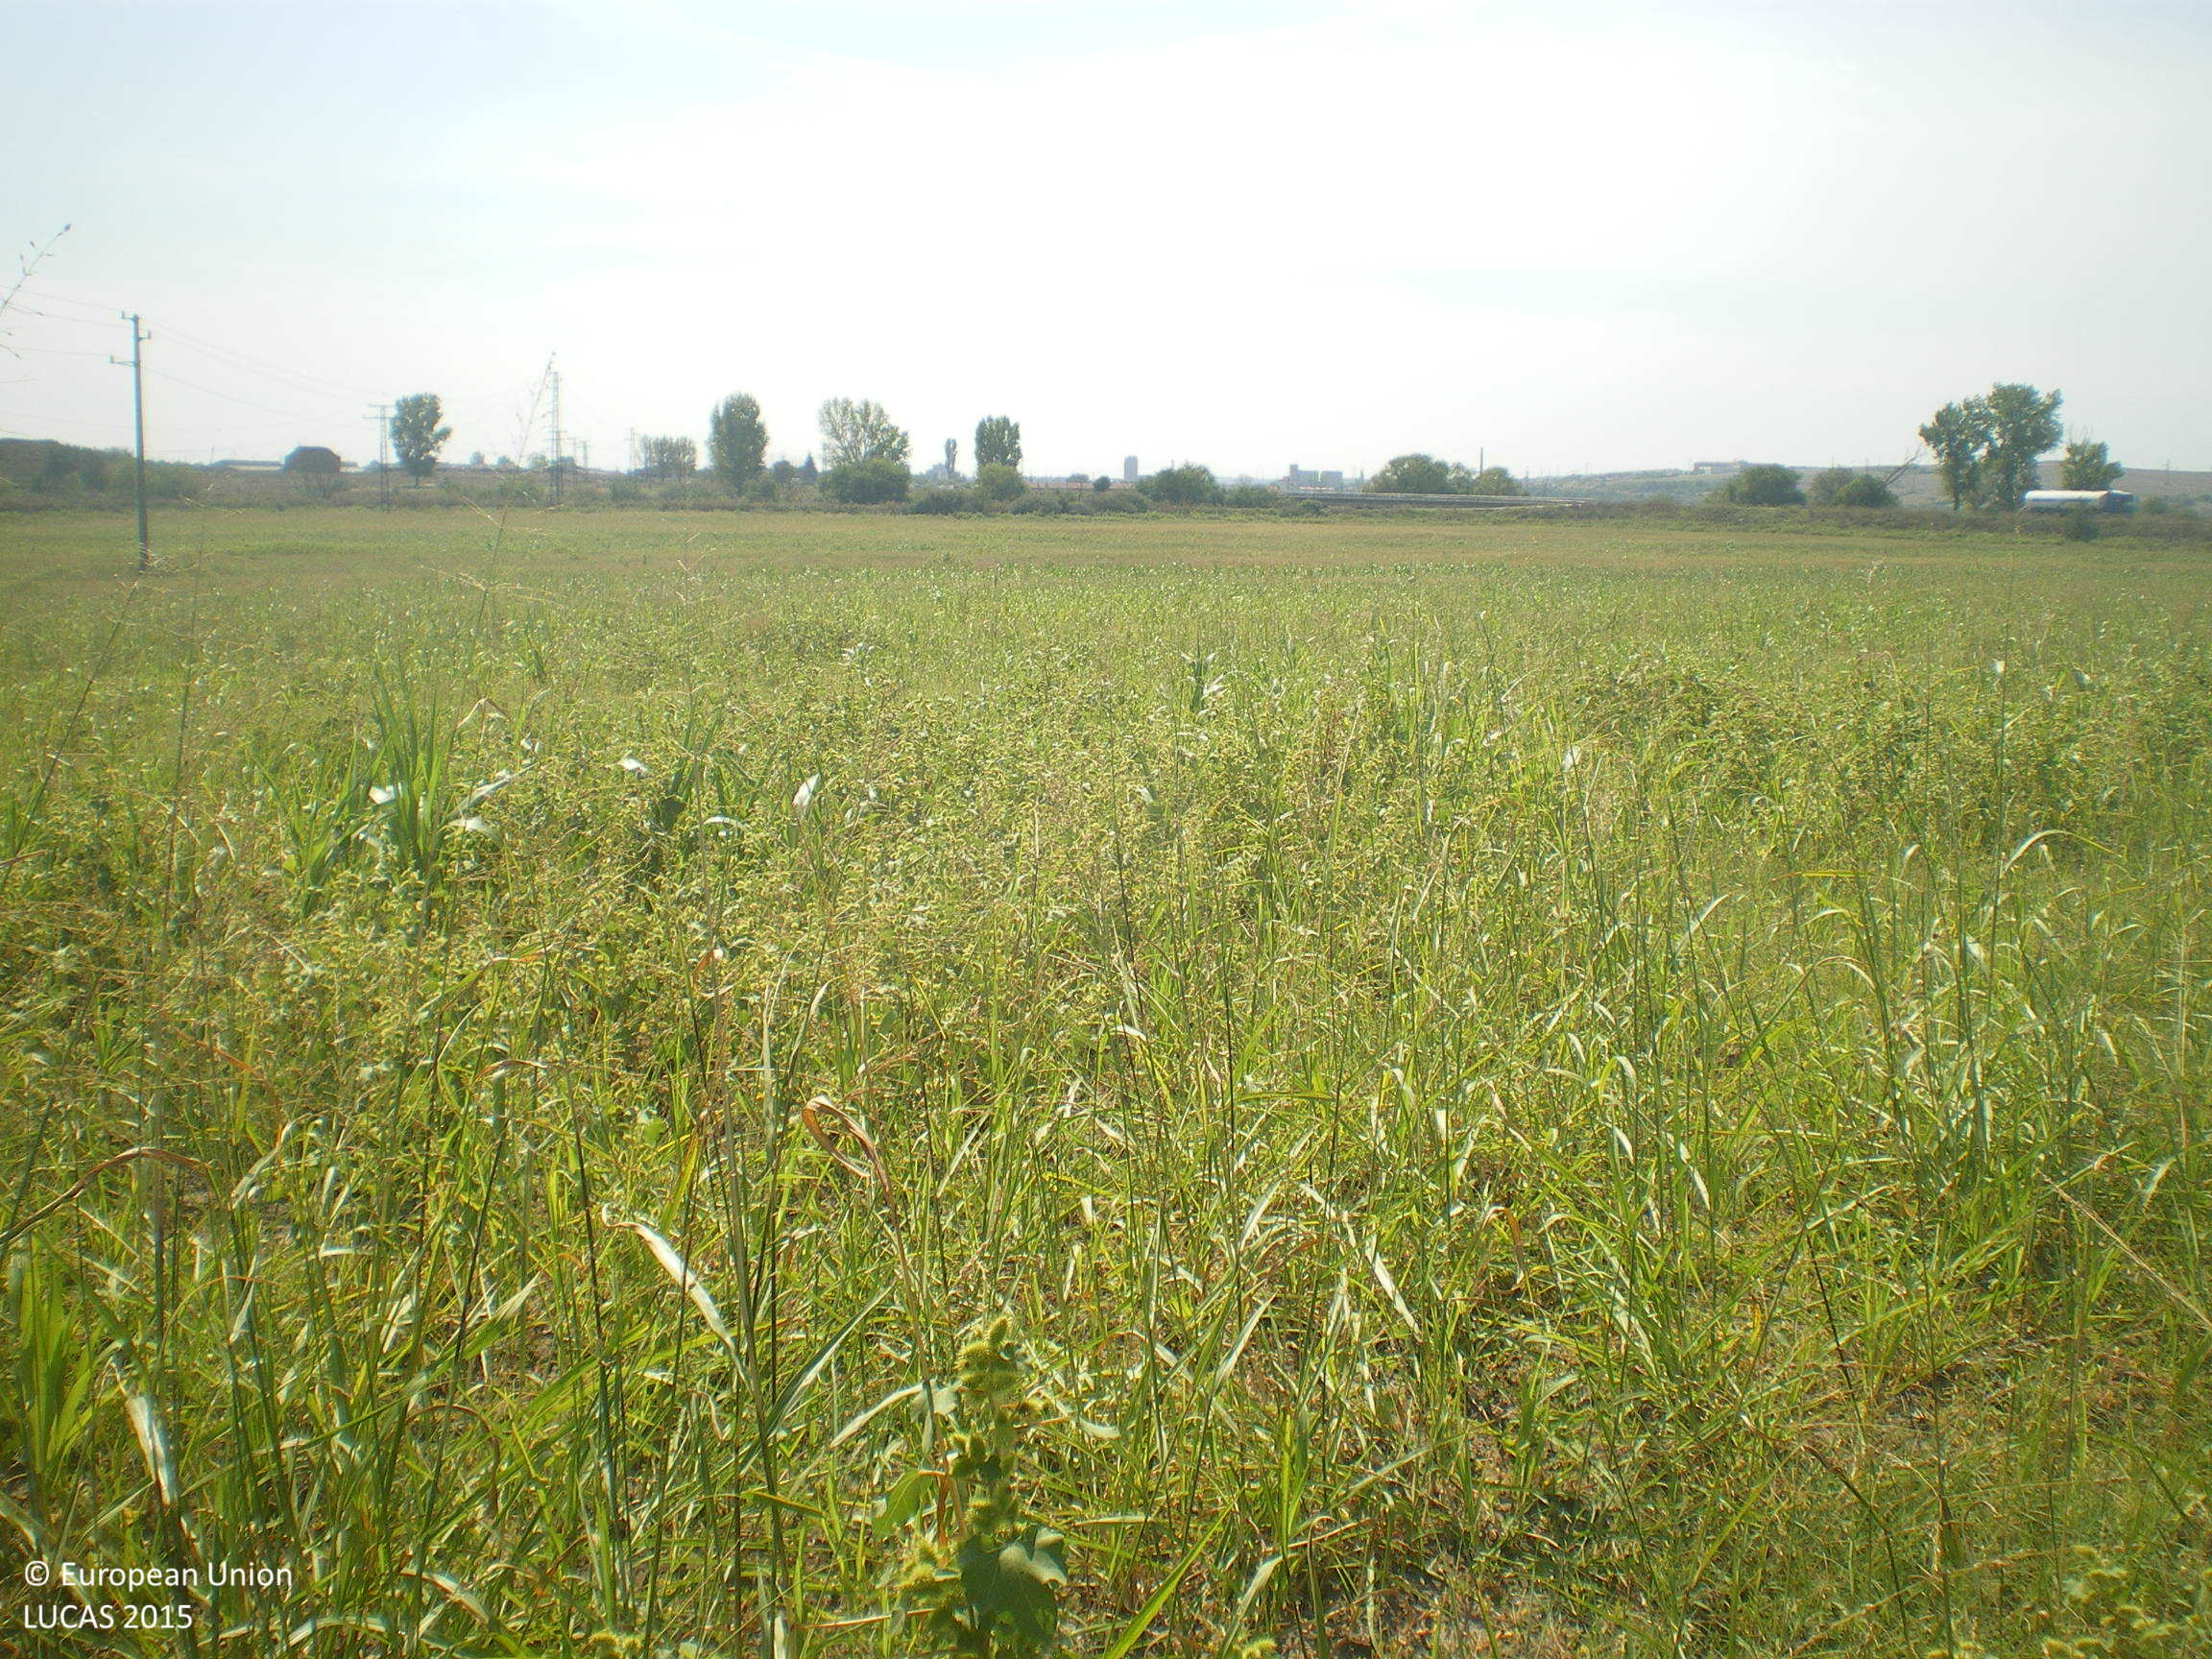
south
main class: Cropland
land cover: Maize
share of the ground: < 10 %
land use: Agriculture (excluding fallow land and kitchen gardens)
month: September
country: BG
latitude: 42.1651
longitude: 25.8697
